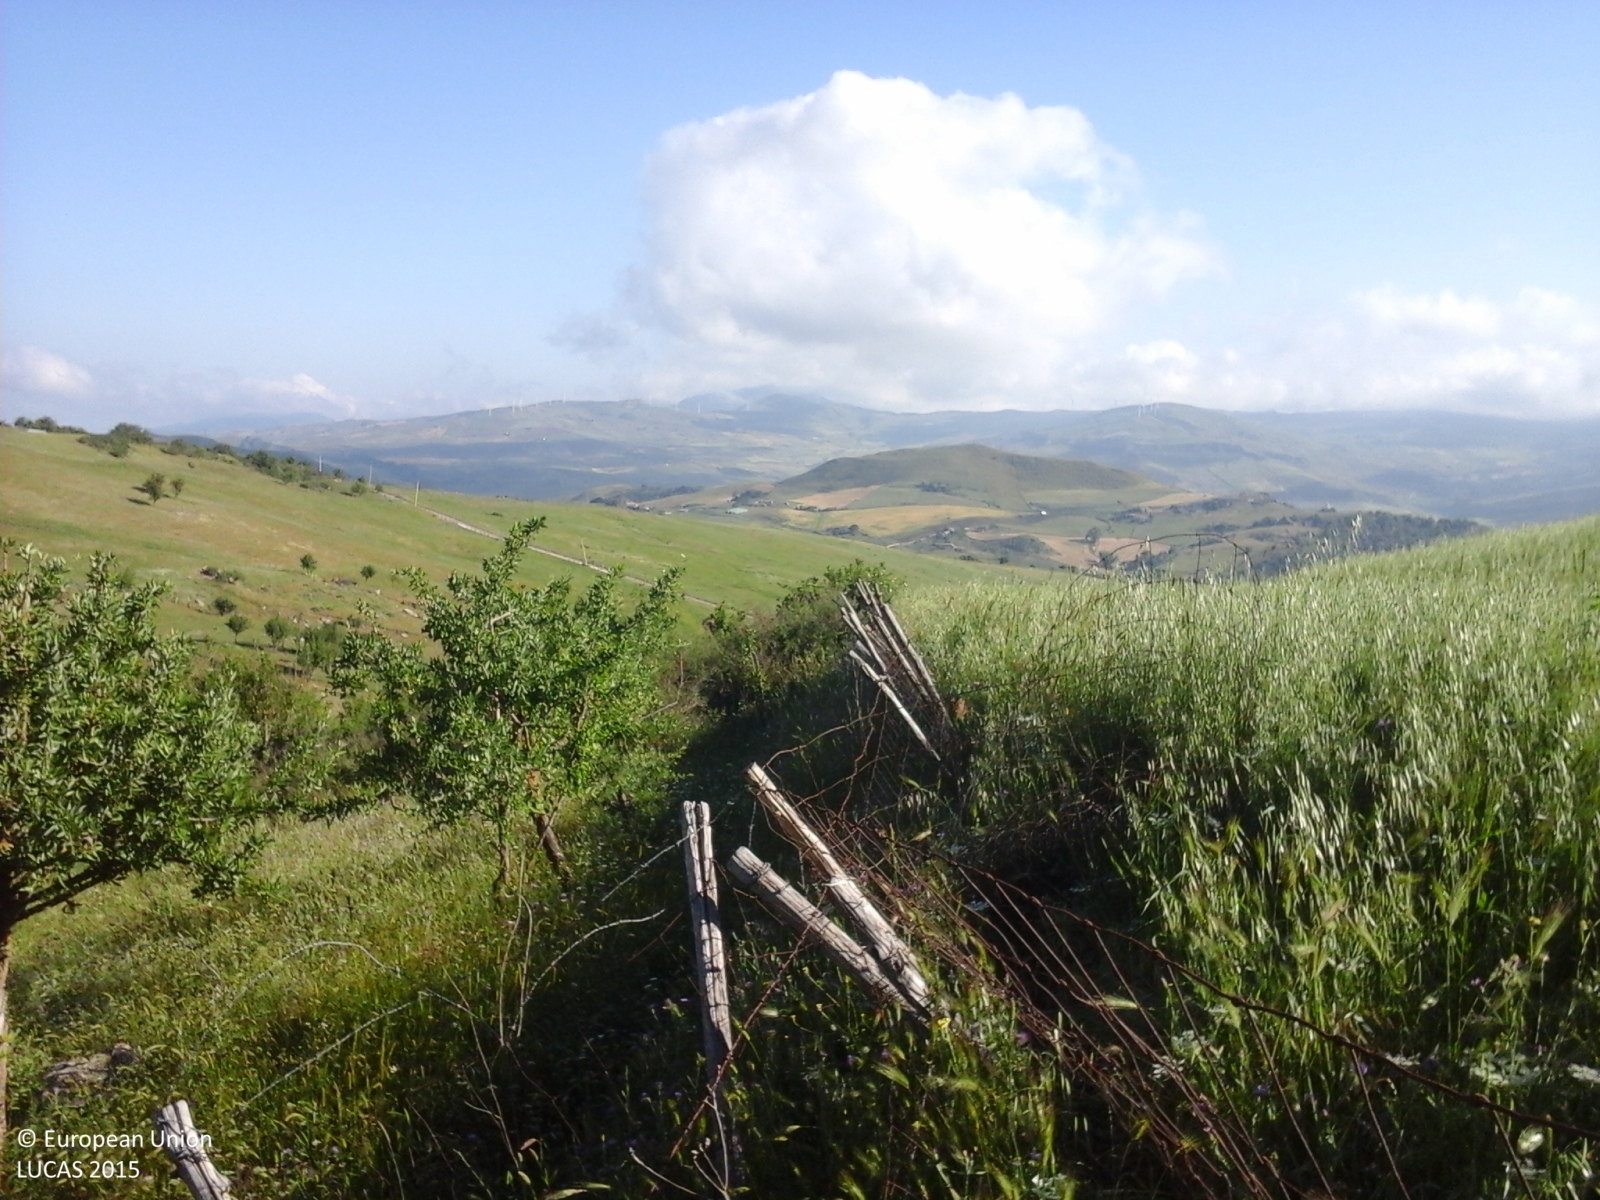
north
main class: Cropland
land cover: Oats
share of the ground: > 75 %
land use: Agriculture (excluding fallow land and kitchen gardens)
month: May
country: IT
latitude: 37.7596
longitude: 14.2941
